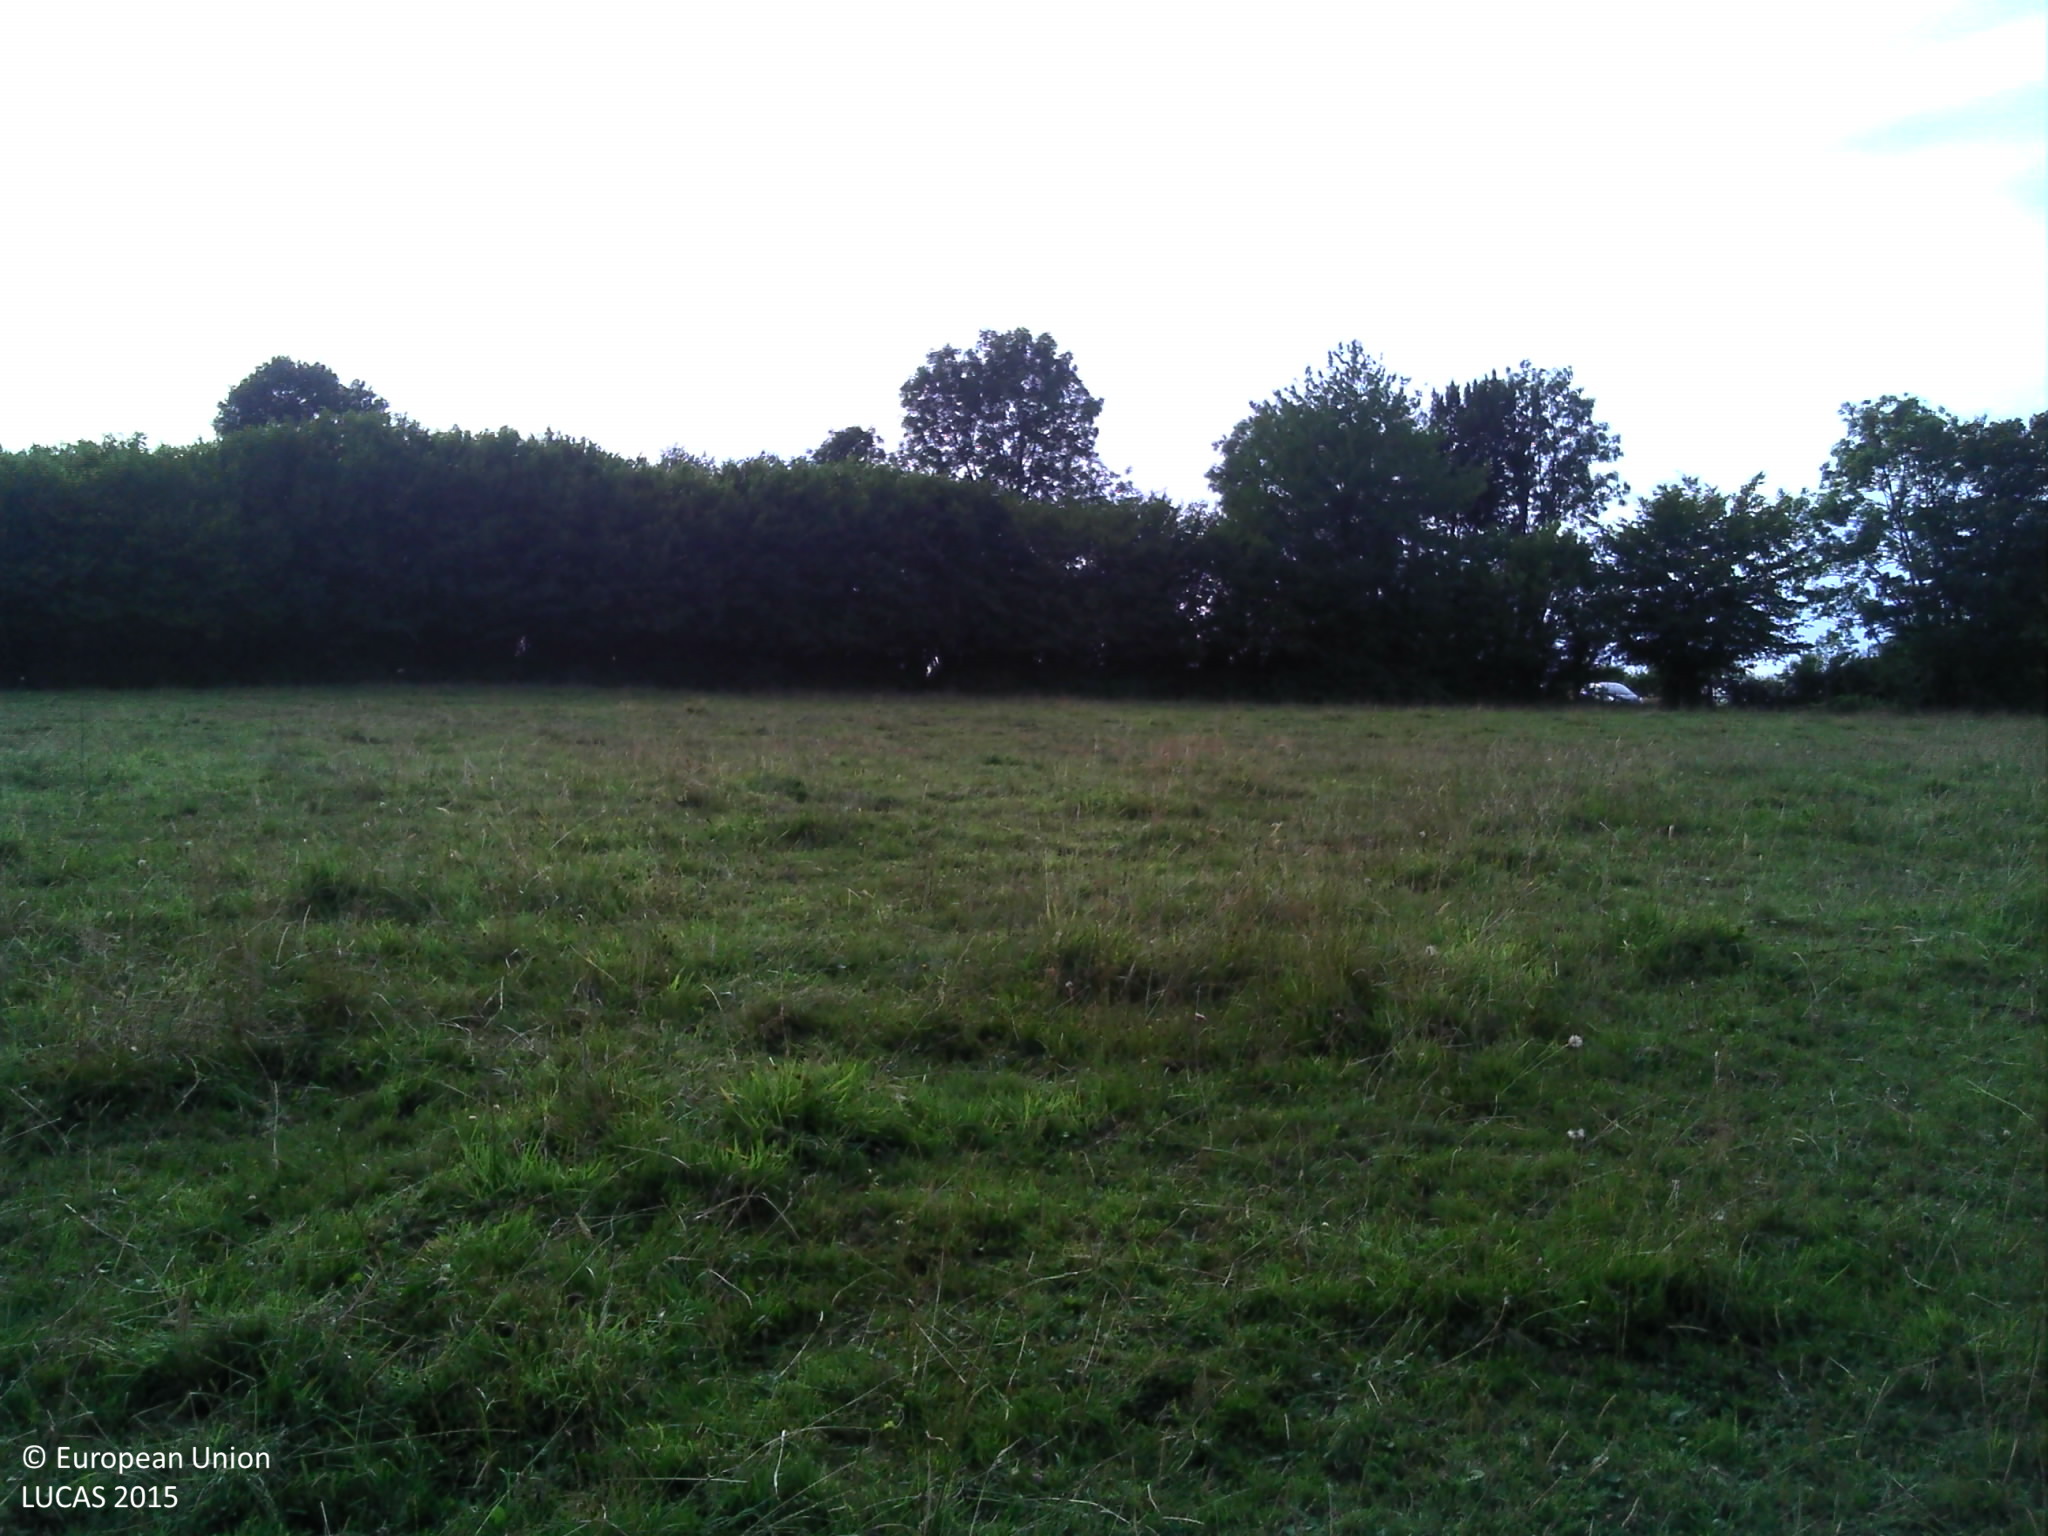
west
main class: Grassland
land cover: Grassland without tree/shrub cover
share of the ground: > 75 %
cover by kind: herbaceous plants 100 %
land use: Agriculture (excluding fallow land and kitchen gardens)
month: July
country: FR
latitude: 48.7005
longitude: 0.5043
